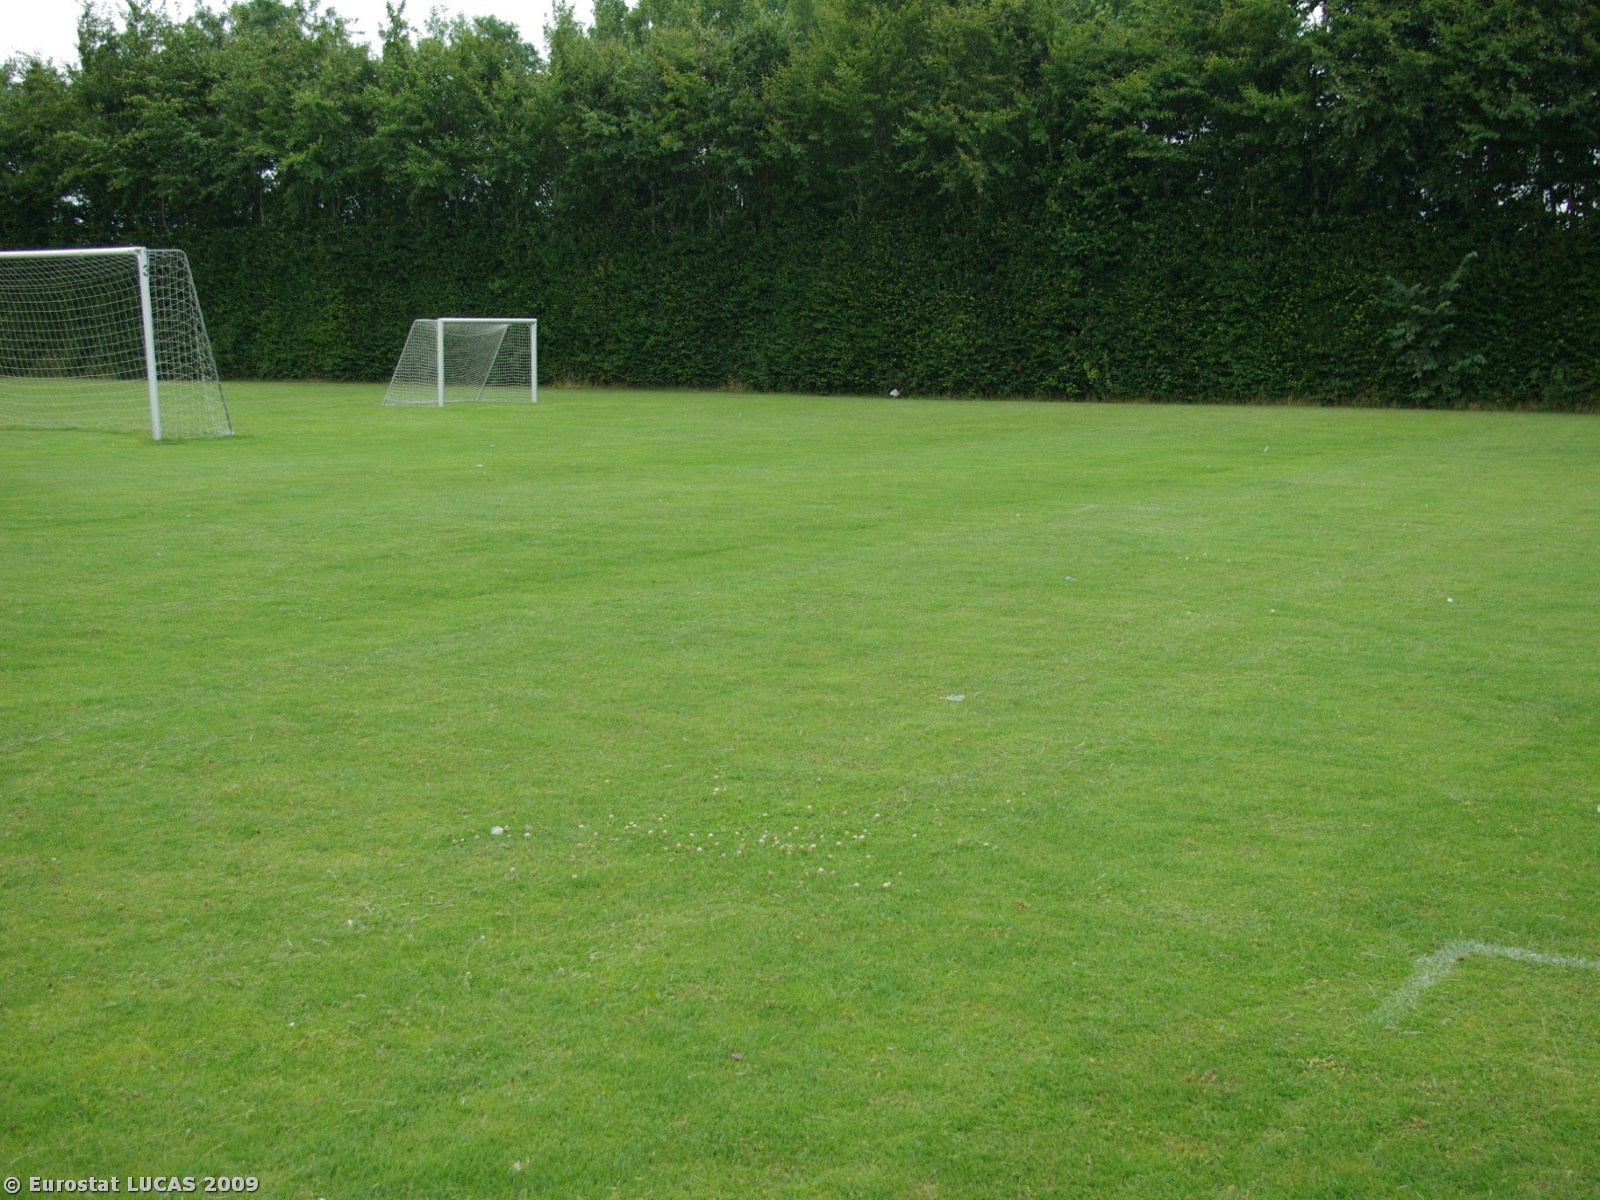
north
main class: Grassland
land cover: Grassland without tree/shrub cover
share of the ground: > 75 %
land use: Sport
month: July
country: DK
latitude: 55.0551
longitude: 9.7654
